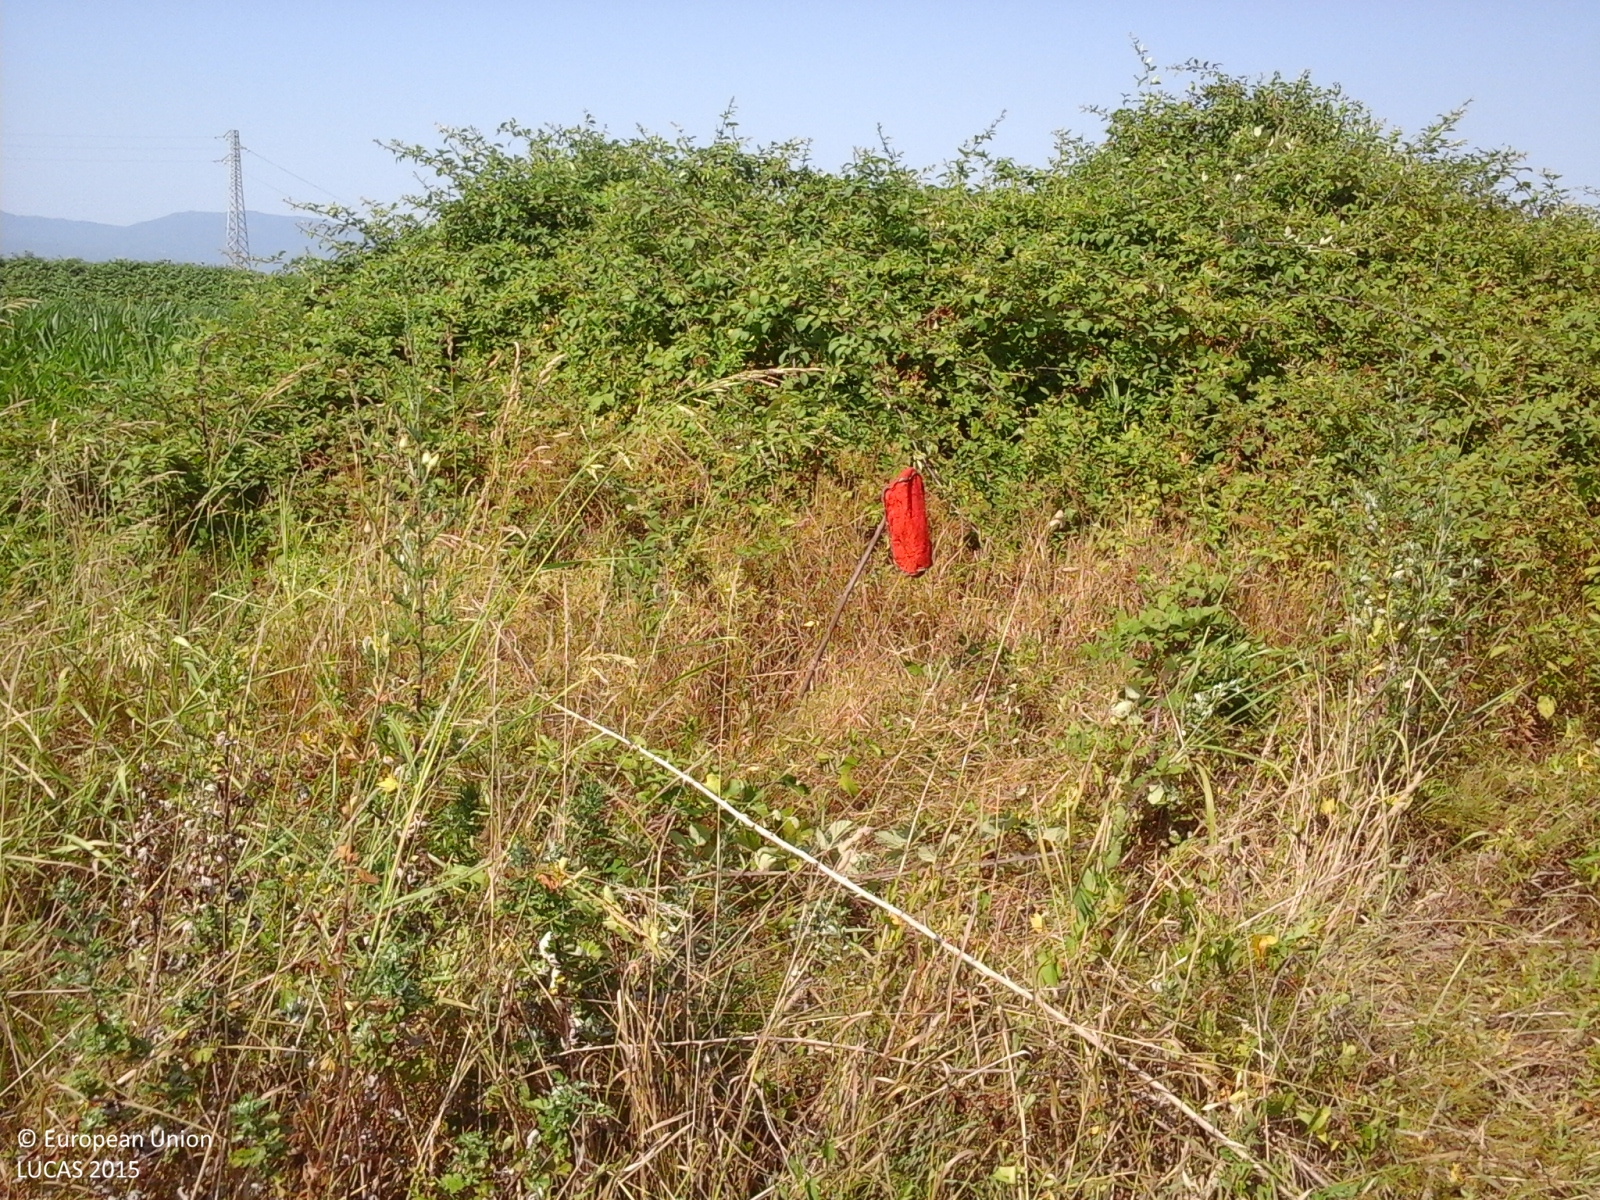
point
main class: Grassland
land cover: Spontaneously vegetated surfaces
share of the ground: > 75 %
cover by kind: herbaceous plants 100 %
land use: Fallow land
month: July
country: IT
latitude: 43.8403
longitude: 11.0297
